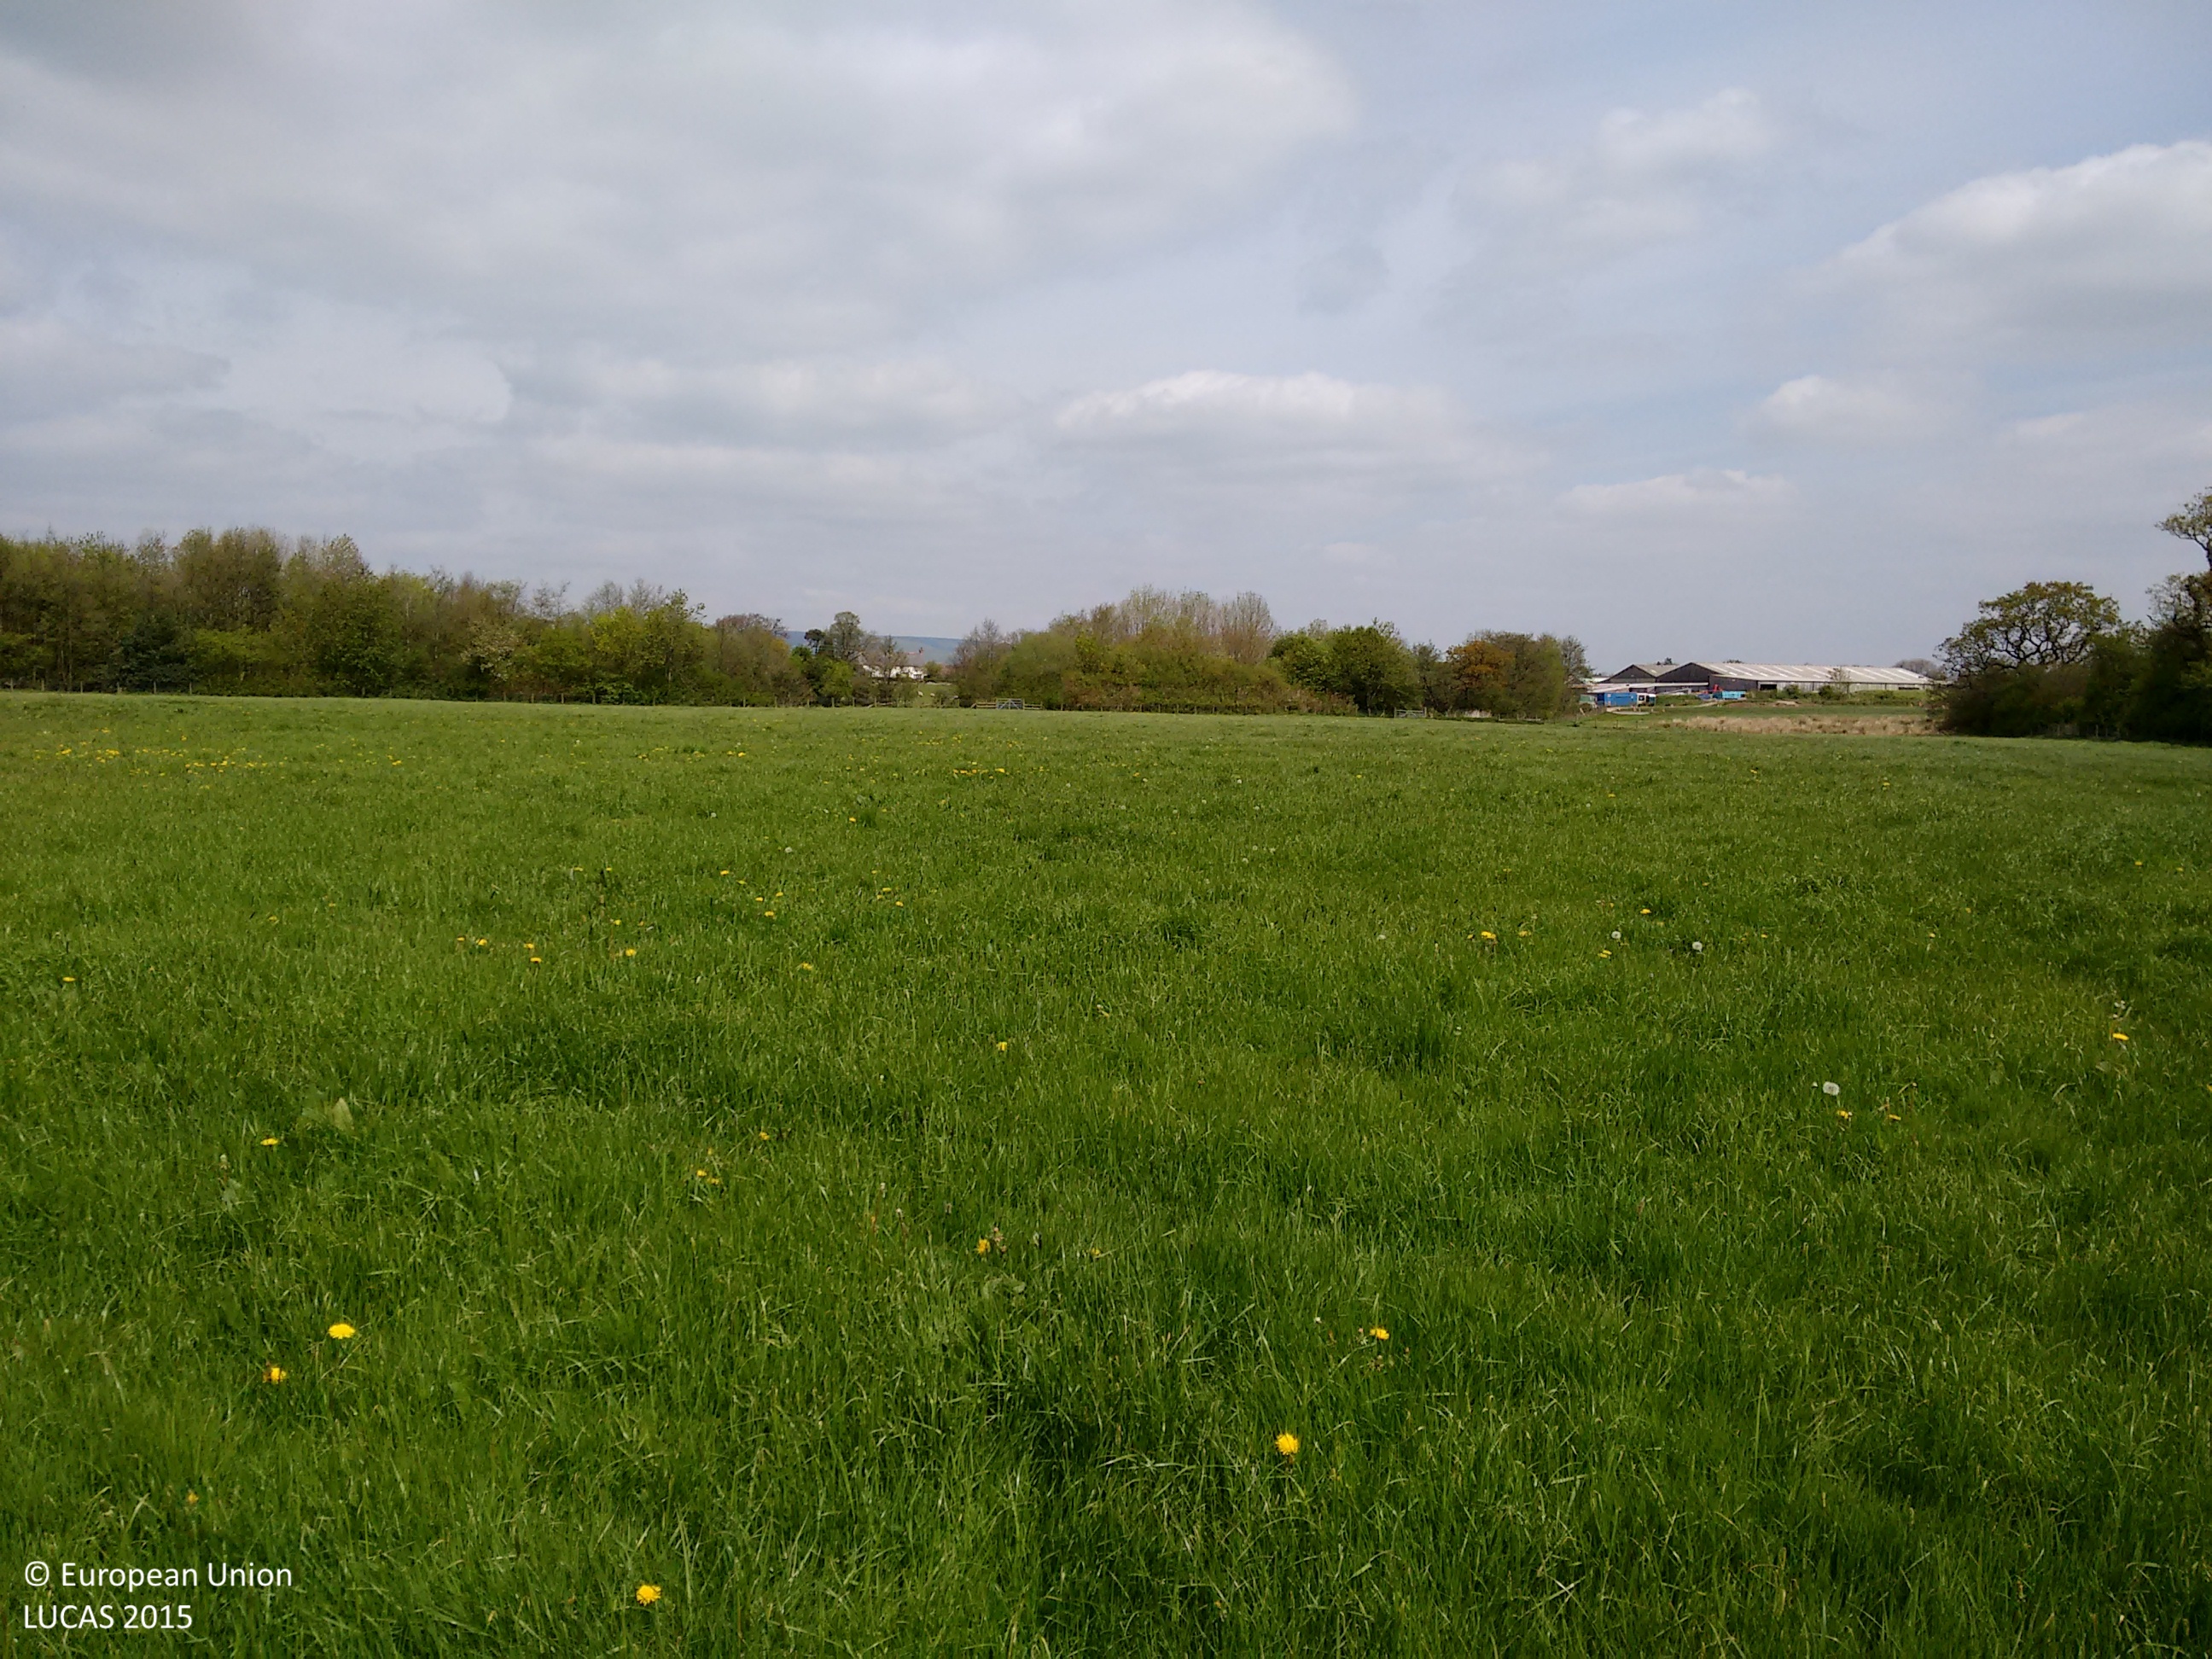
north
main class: Grassland
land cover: Grassland without tree/shrub cover
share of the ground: > 75 %
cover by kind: herbaceous plants 100 %
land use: Agriculture (excluding fallow land and kitchen gardens)
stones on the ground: < 10 %
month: May
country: GB
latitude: 53.8296
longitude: -2.6324
